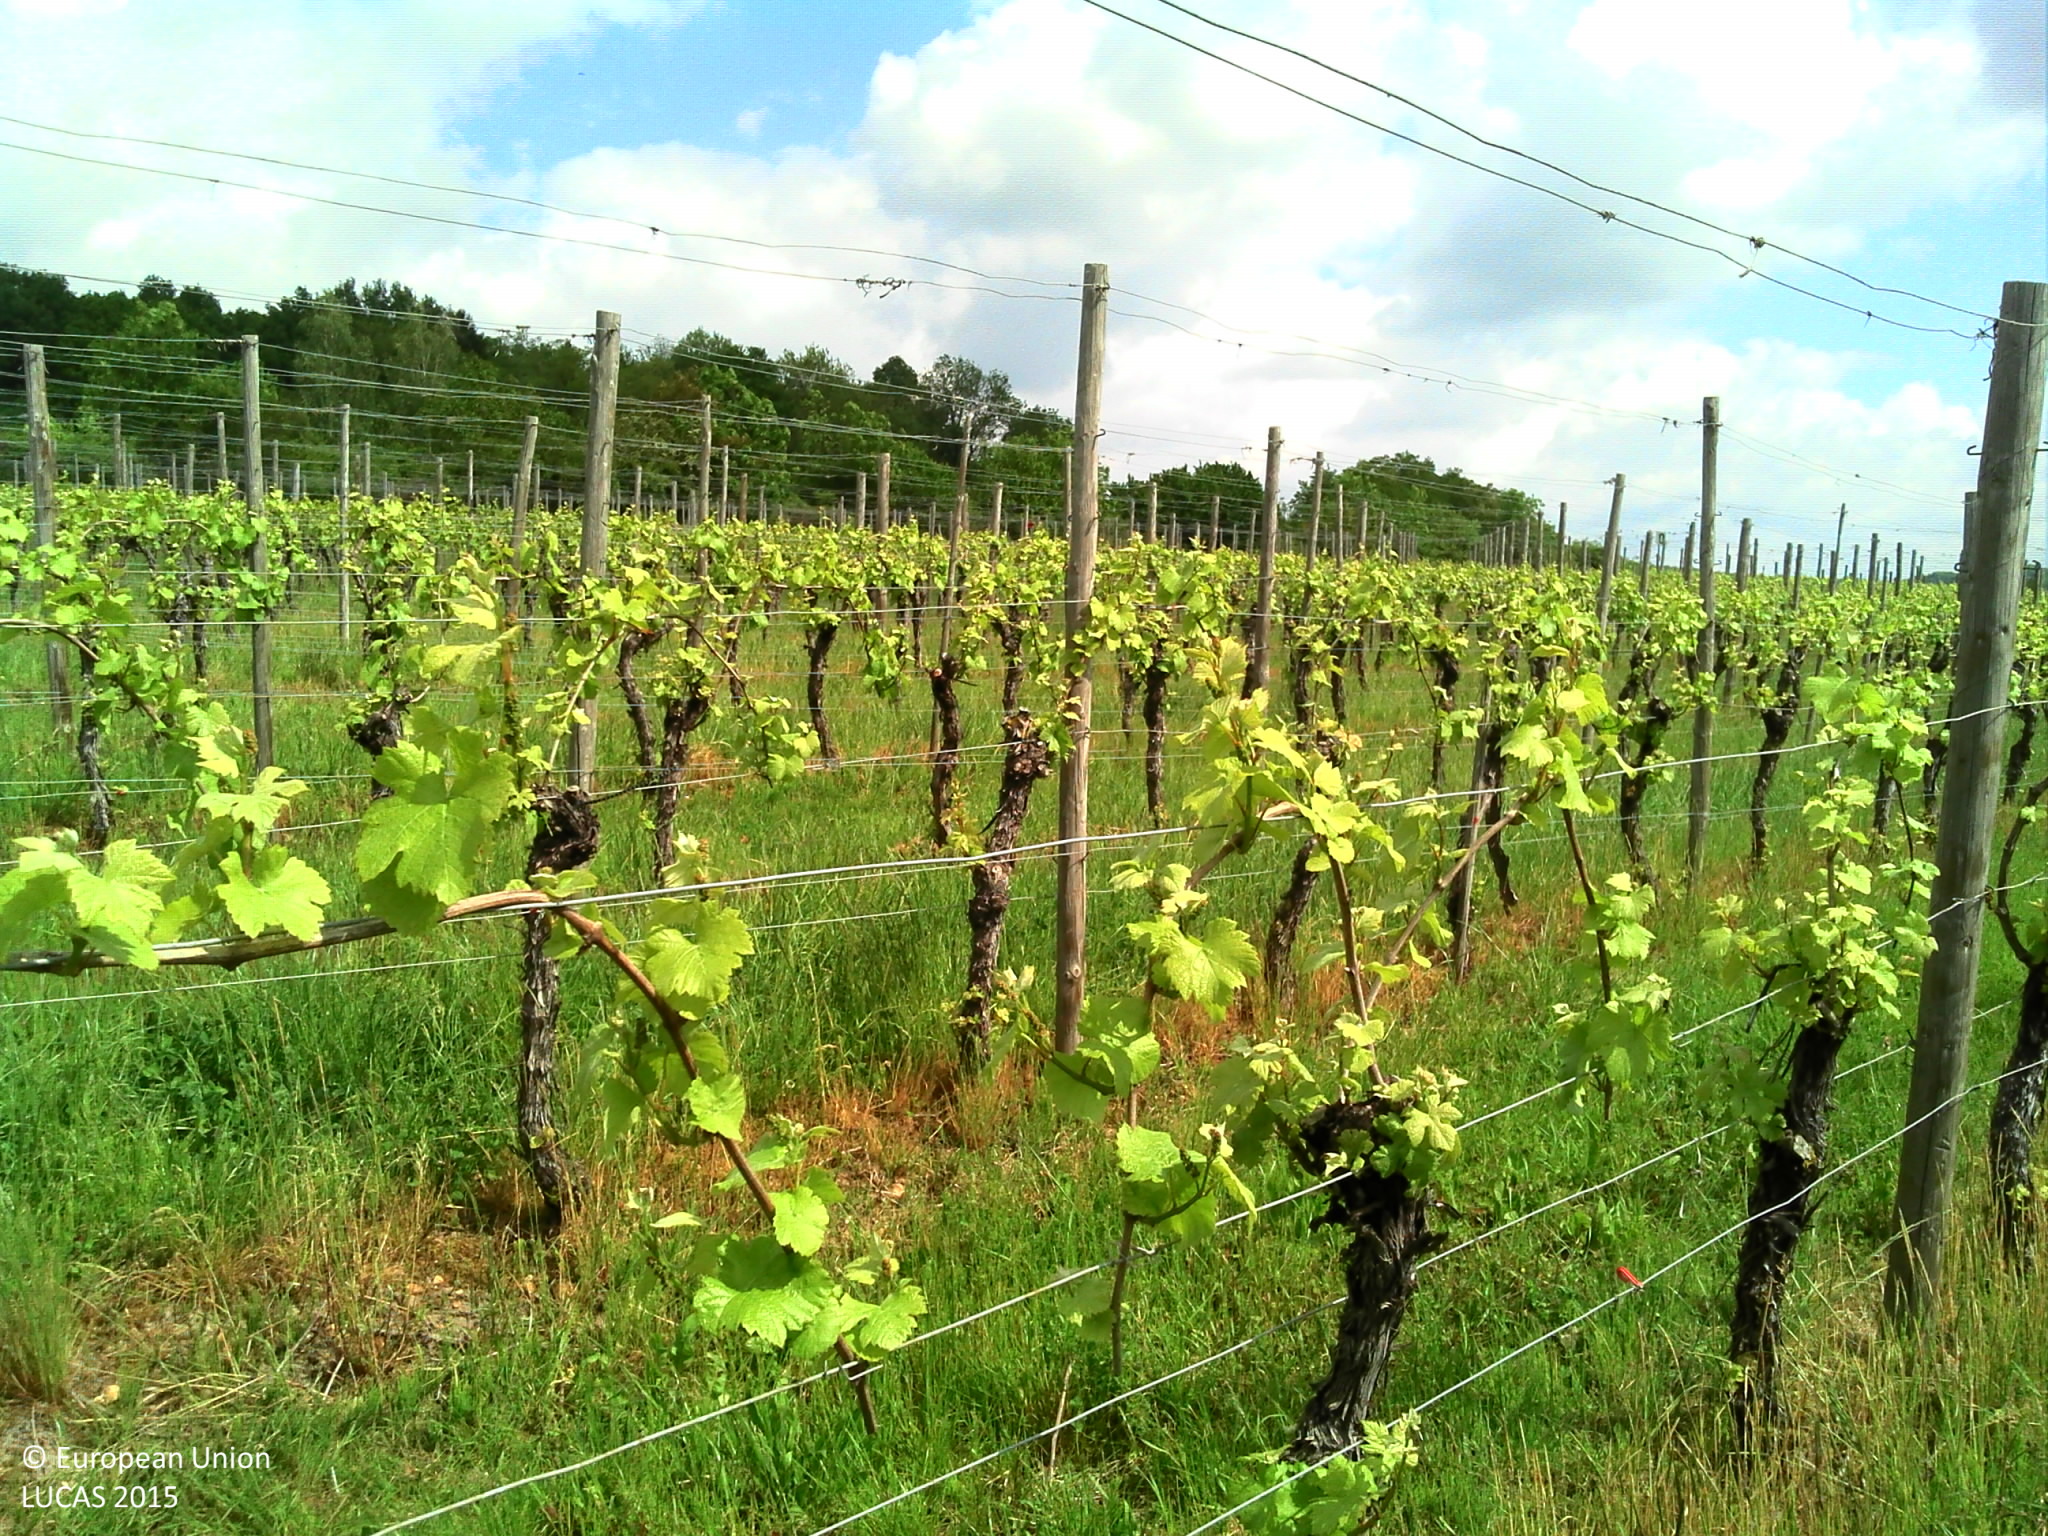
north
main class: Cropland
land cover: Vineyards
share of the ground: > 75 %
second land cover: Spontaneously vegetated surfaces
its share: > 75 %
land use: Agriculture (excluding fallow land and kitchen gardens)
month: May
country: LU
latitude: 49.6974
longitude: 6.4644
